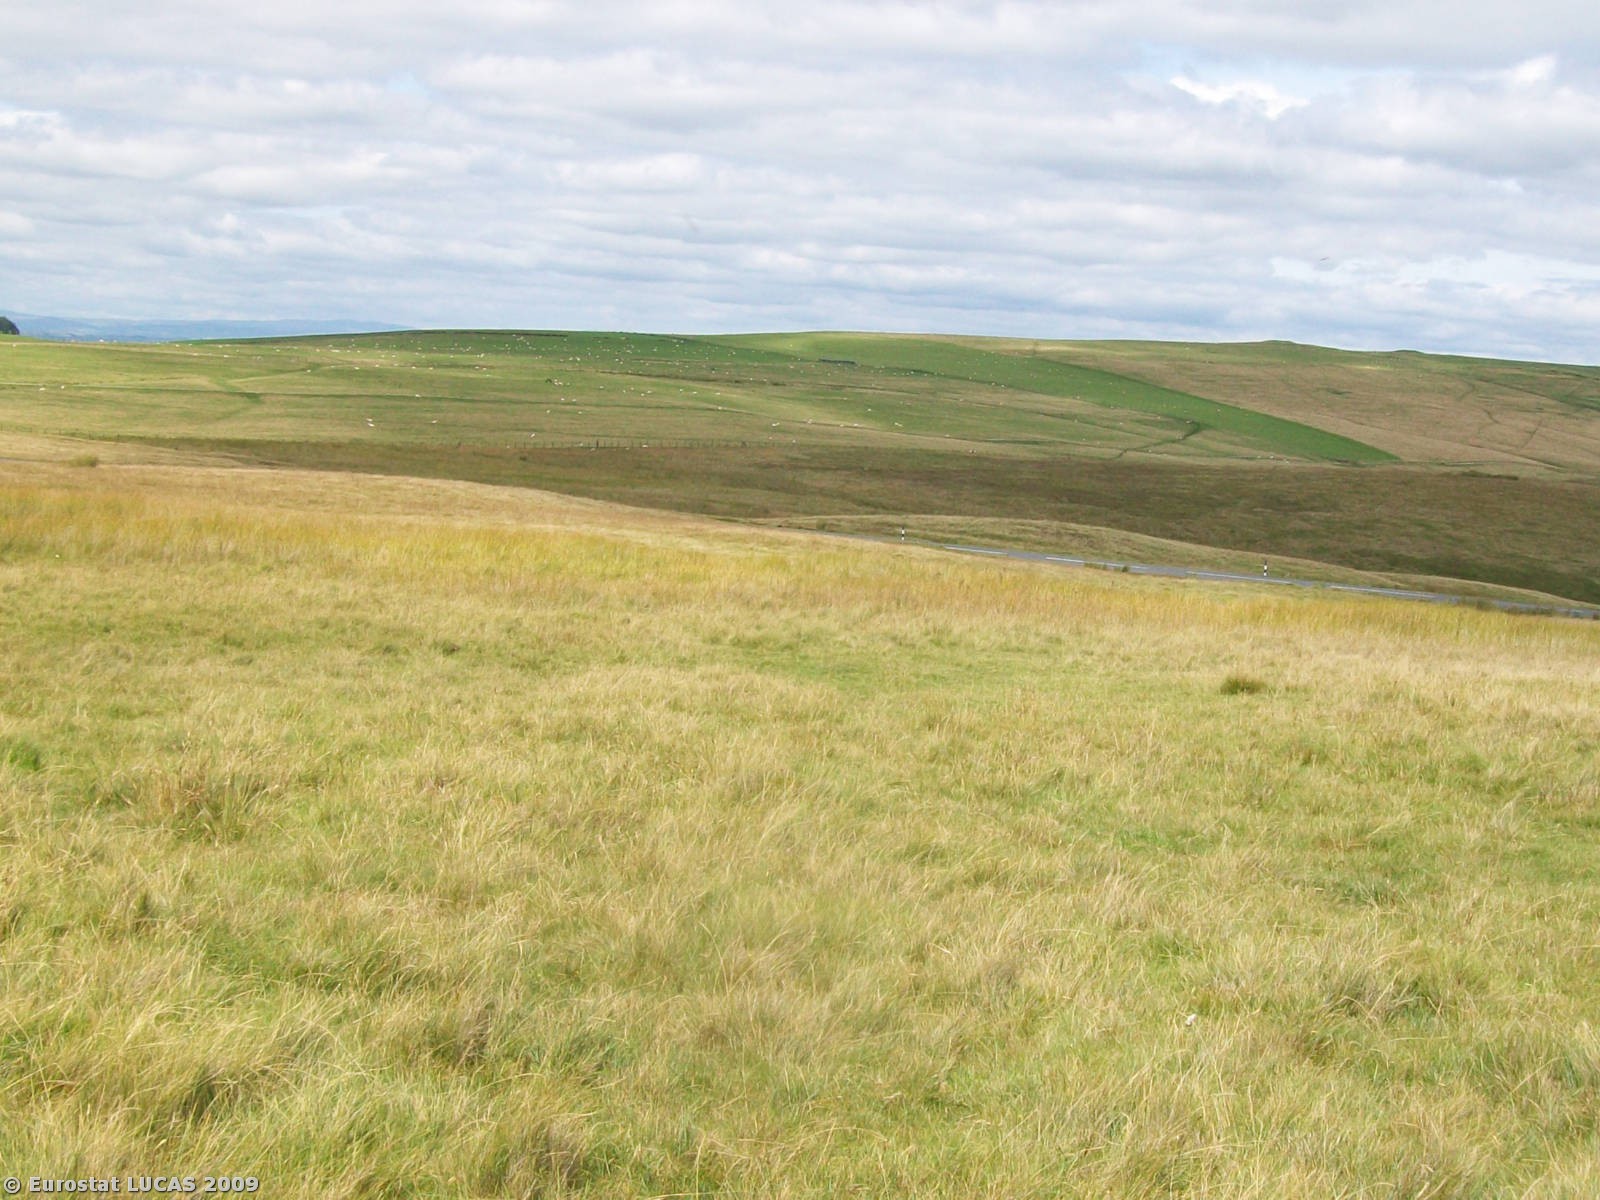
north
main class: Grassland
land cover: Grassland without tree/shrub cover
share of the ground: > 75 %
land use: Agriculture (excluding fallow land and kitchen gardens)
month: August
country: GB
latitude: 52.4444
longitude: -3.3070
